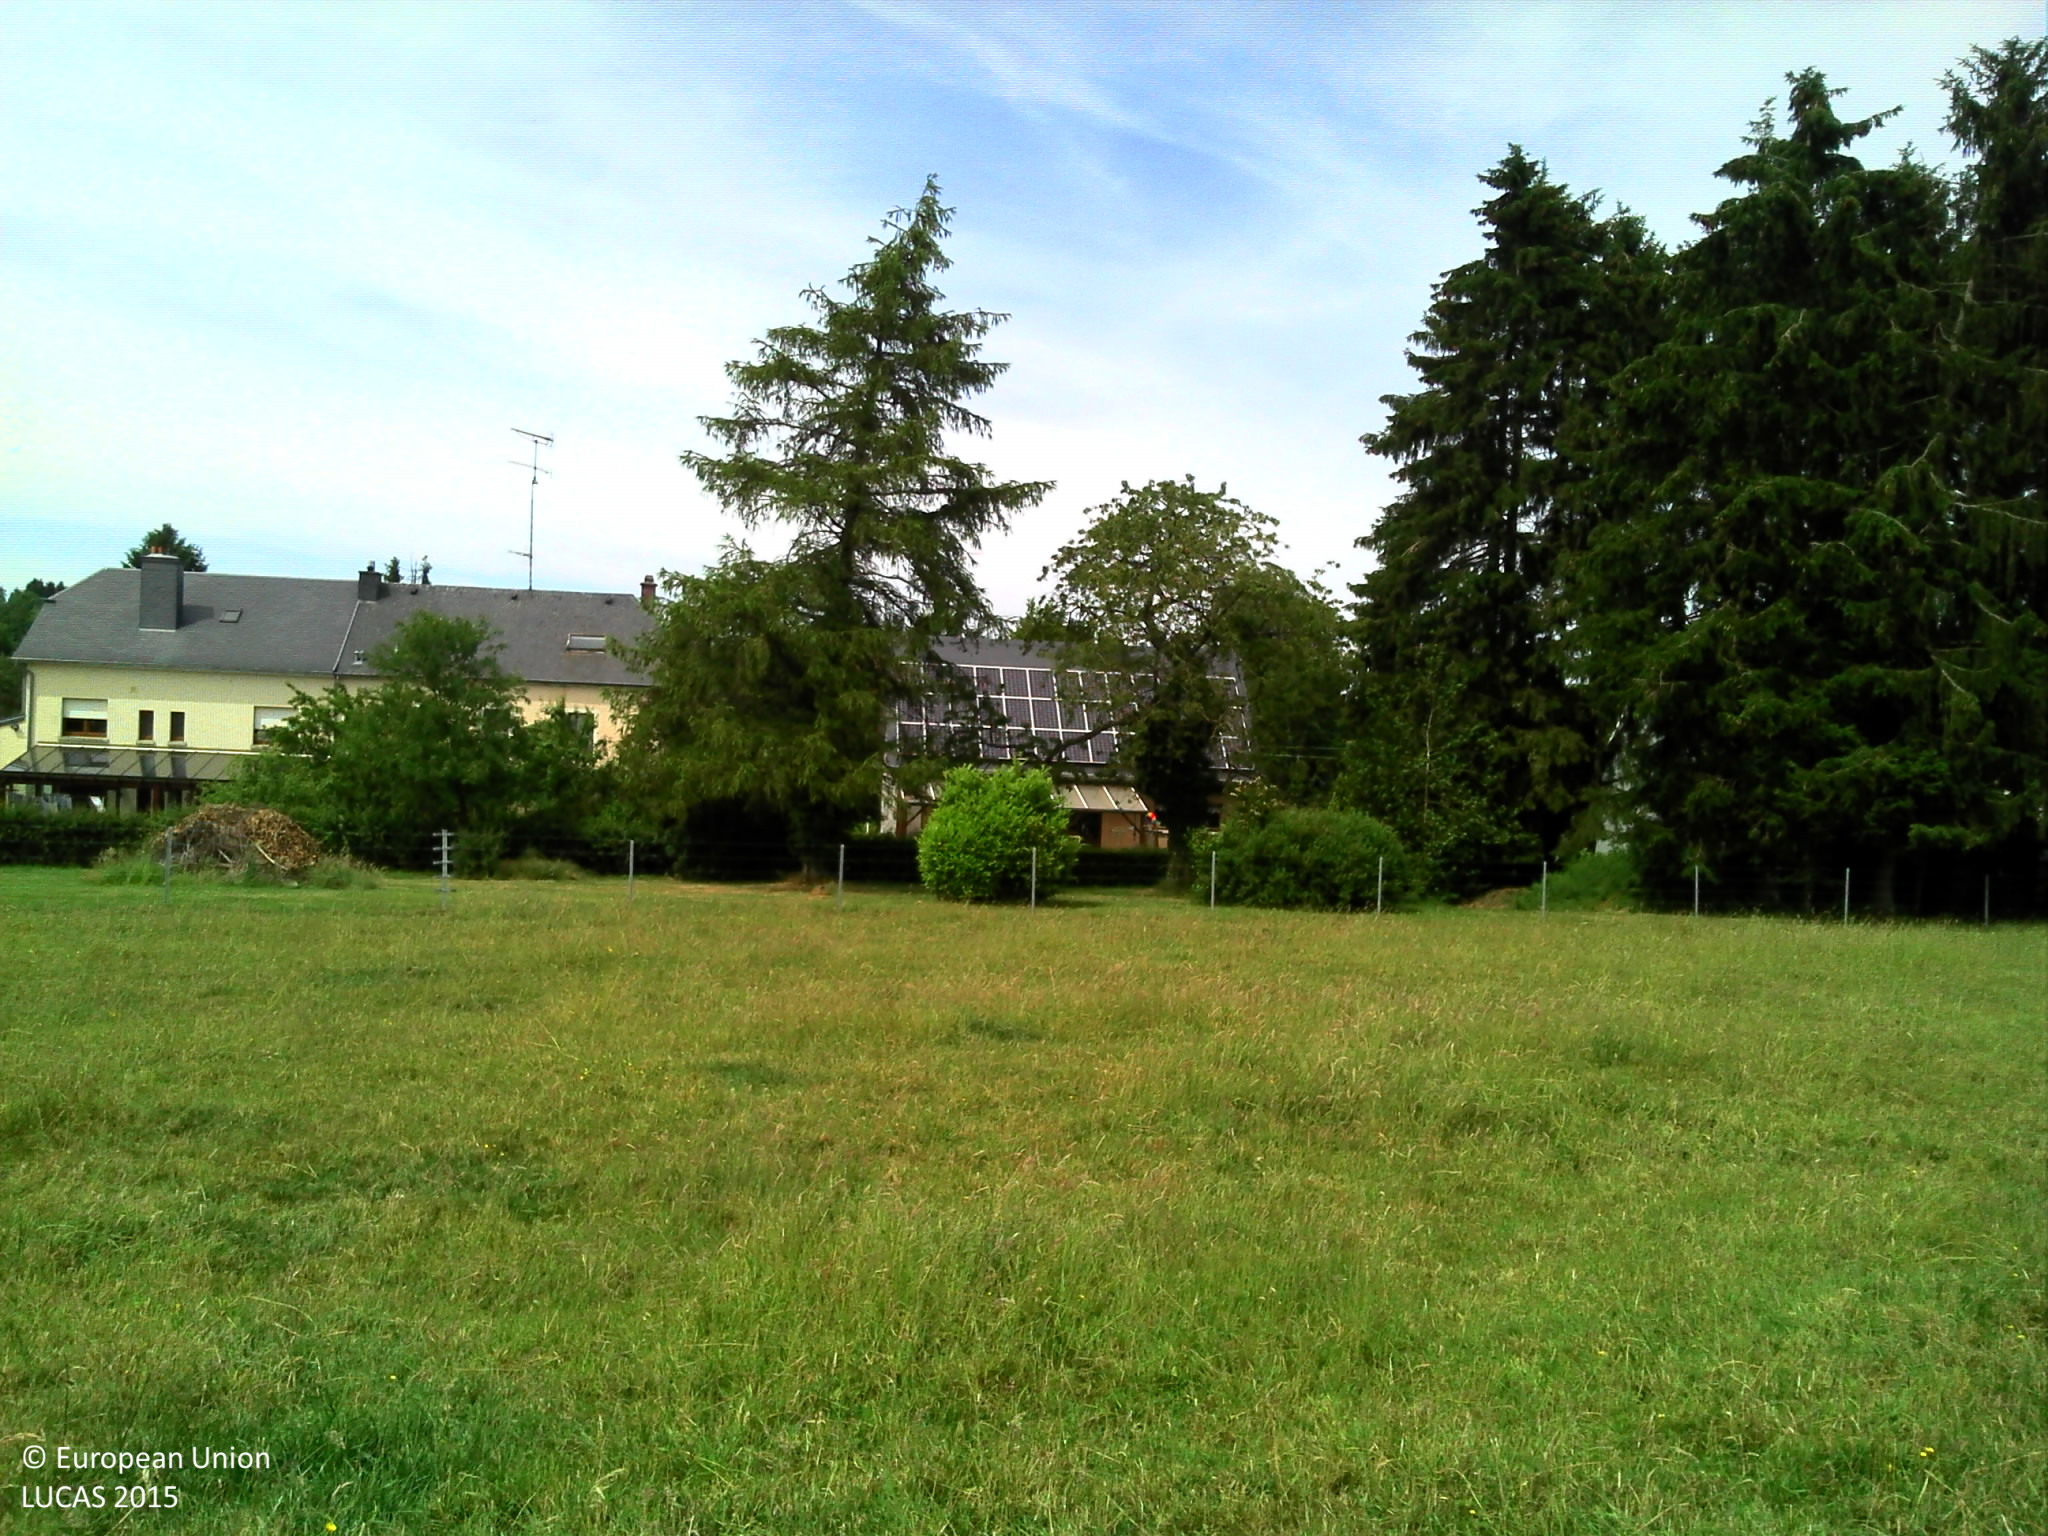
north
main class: Grassland
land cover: Grassland without tree/shrub cover
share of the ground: > 75 %
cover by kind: herbaceous plants 100 %
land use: Agriculture (excluding fallow land and kitchen gardens)
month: June
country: LU
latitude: 49.6429
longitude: 5.9138
